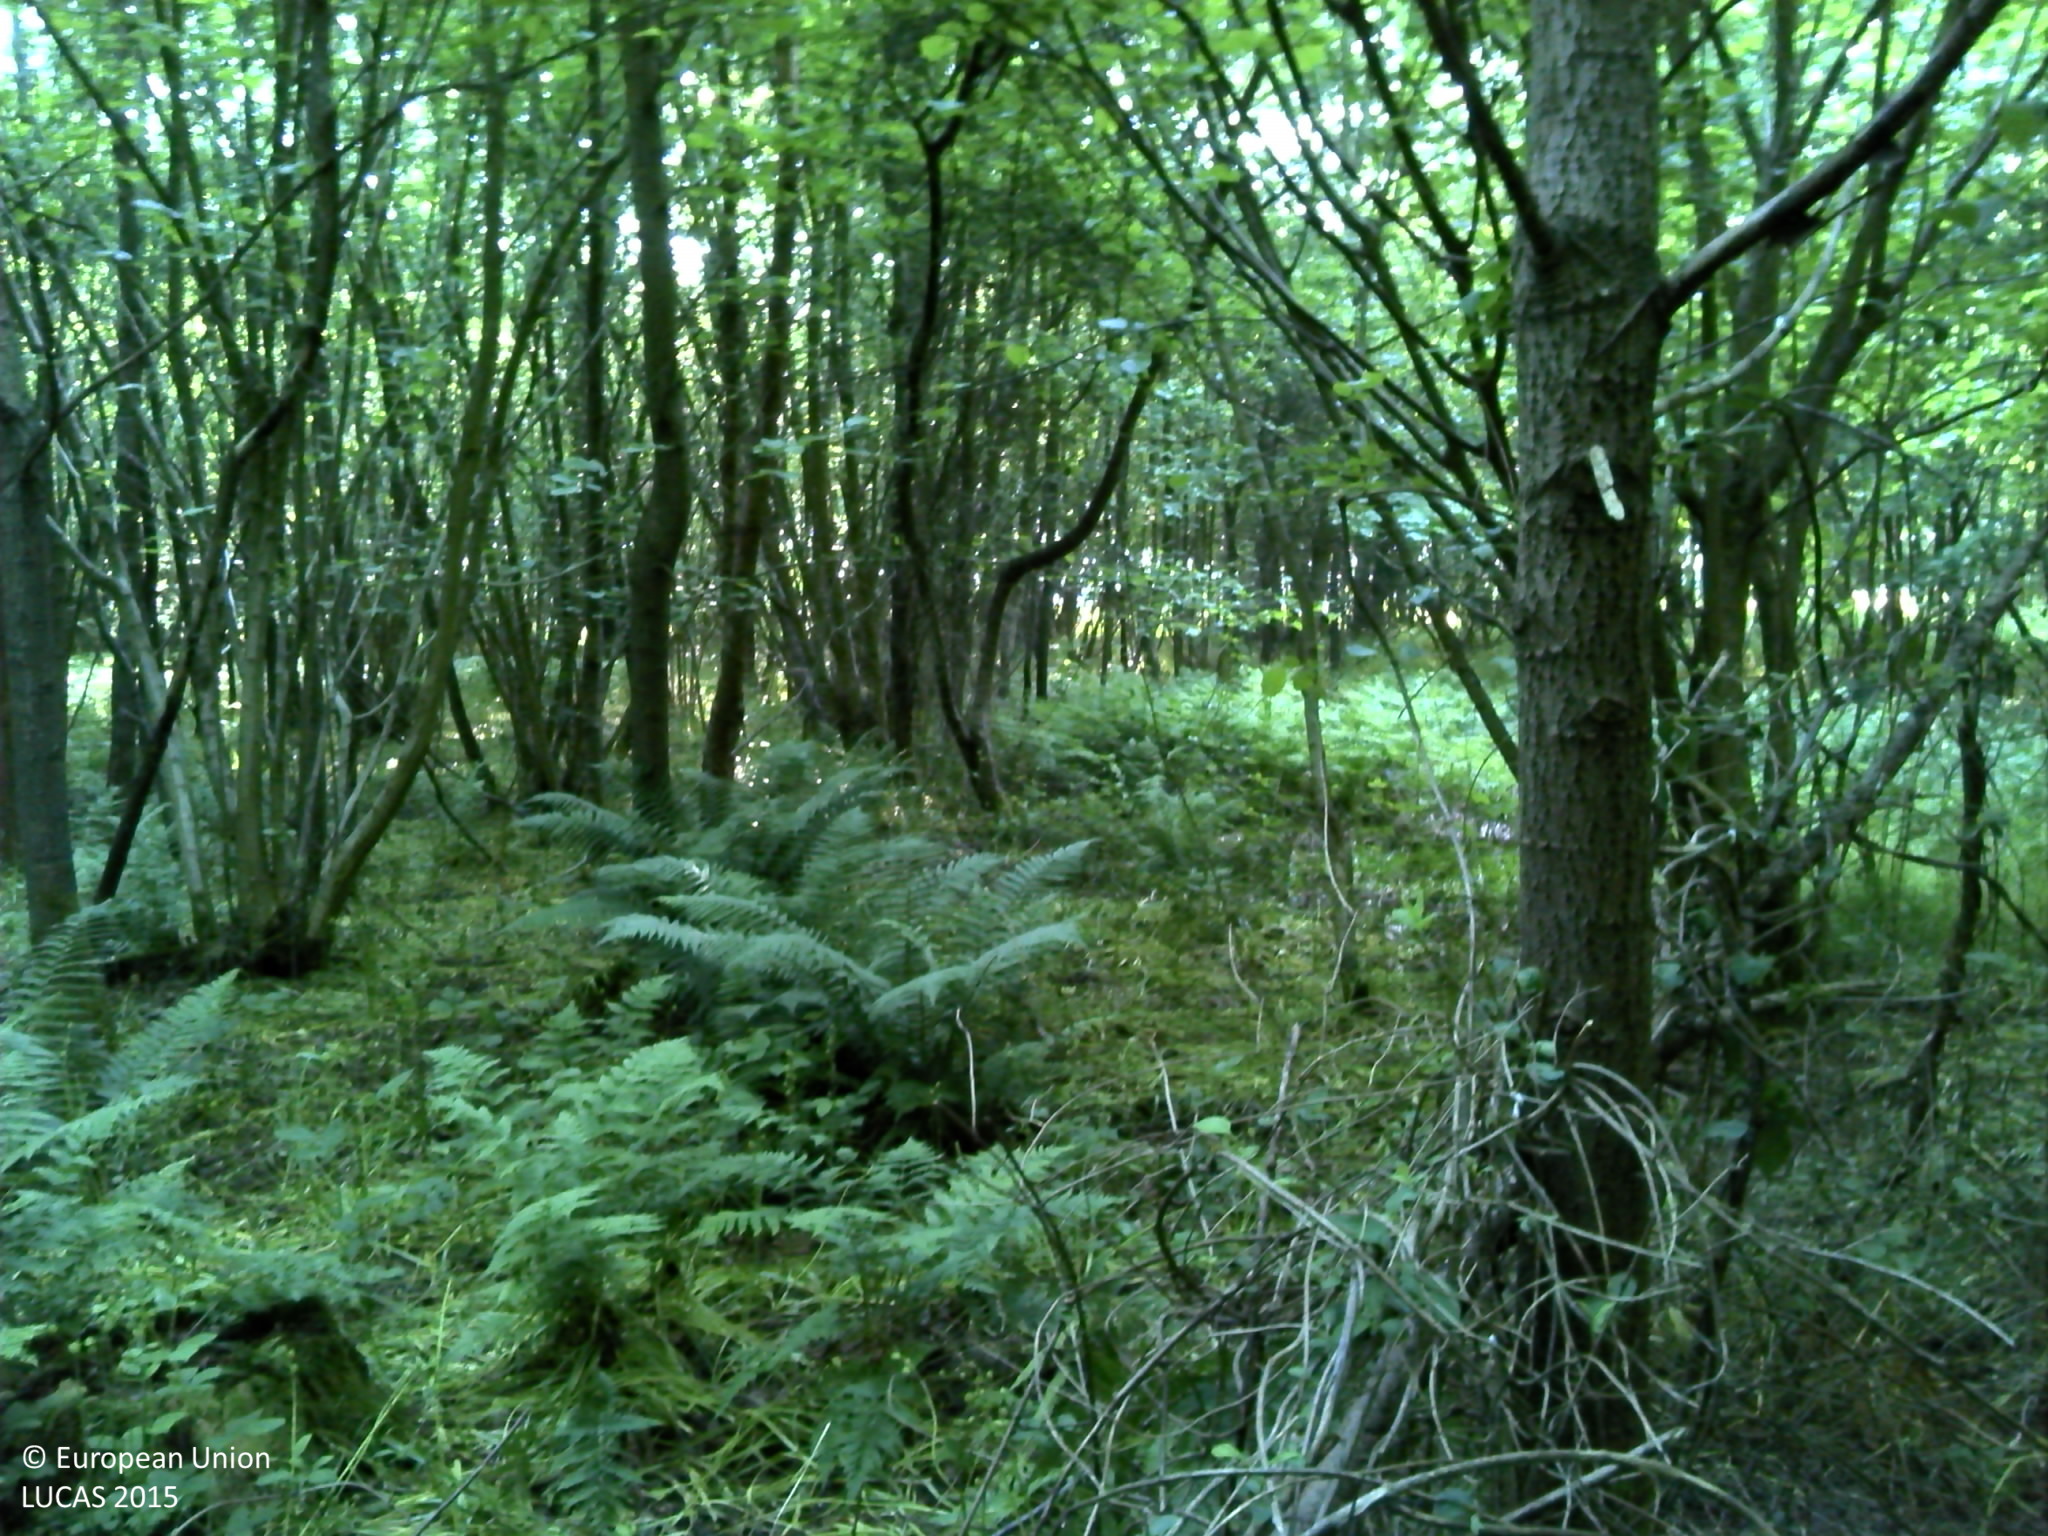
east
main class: Woodland
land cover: Broadleaved woodland
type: mesophytic deciduous forest
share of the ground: > 75 %
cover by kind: broadleaved forest trees 80 %, herbaceous plants 20 %
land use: Forestry
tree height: > 5 m
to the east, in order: Broadleaved woodland; Grassland without tree/shrub cover; Sugar beet; Common wheat
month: June
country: FR
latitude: 49.6946
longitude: 1.1478
